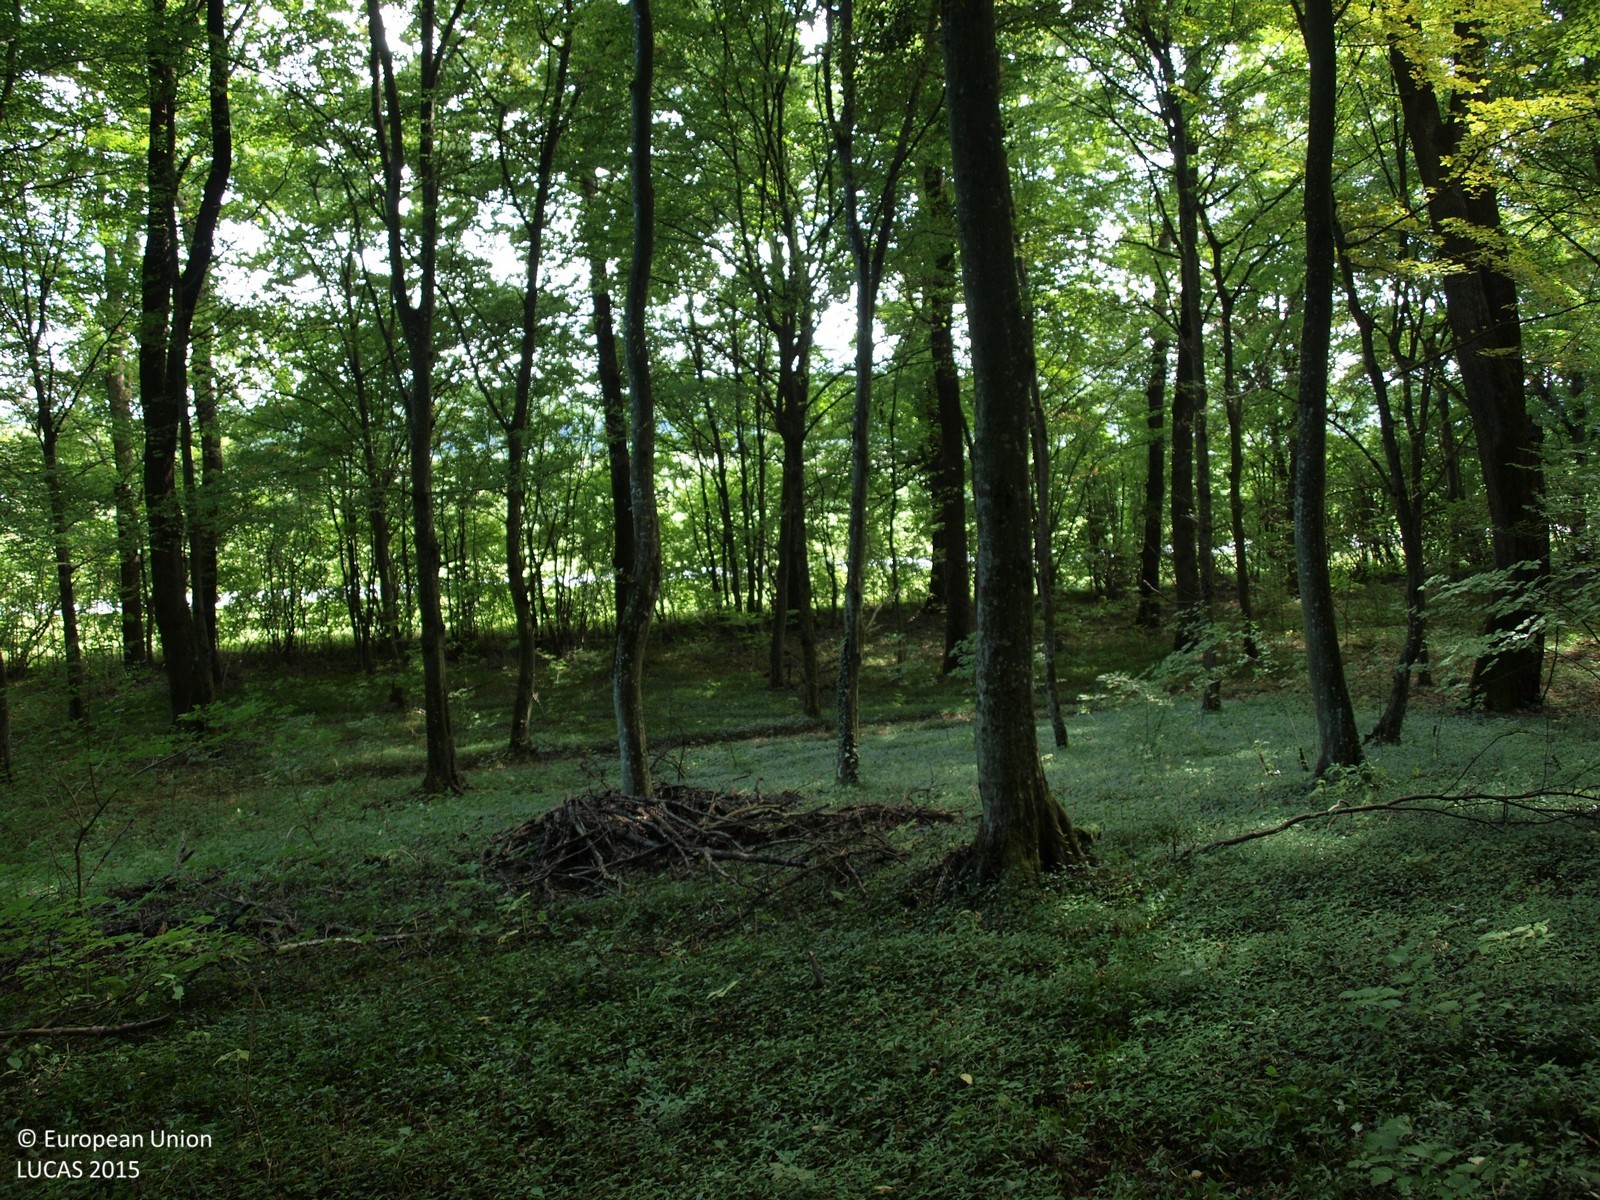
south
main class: Woodland
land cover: Broadleaved woodland
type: mesophytic deciduous forest
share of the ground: > 75 %
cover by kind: broadleaved forest trees 100 %
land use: Forestry
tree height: > 5 m
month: August
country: HR
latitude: 46.0224
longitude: 16.5751
